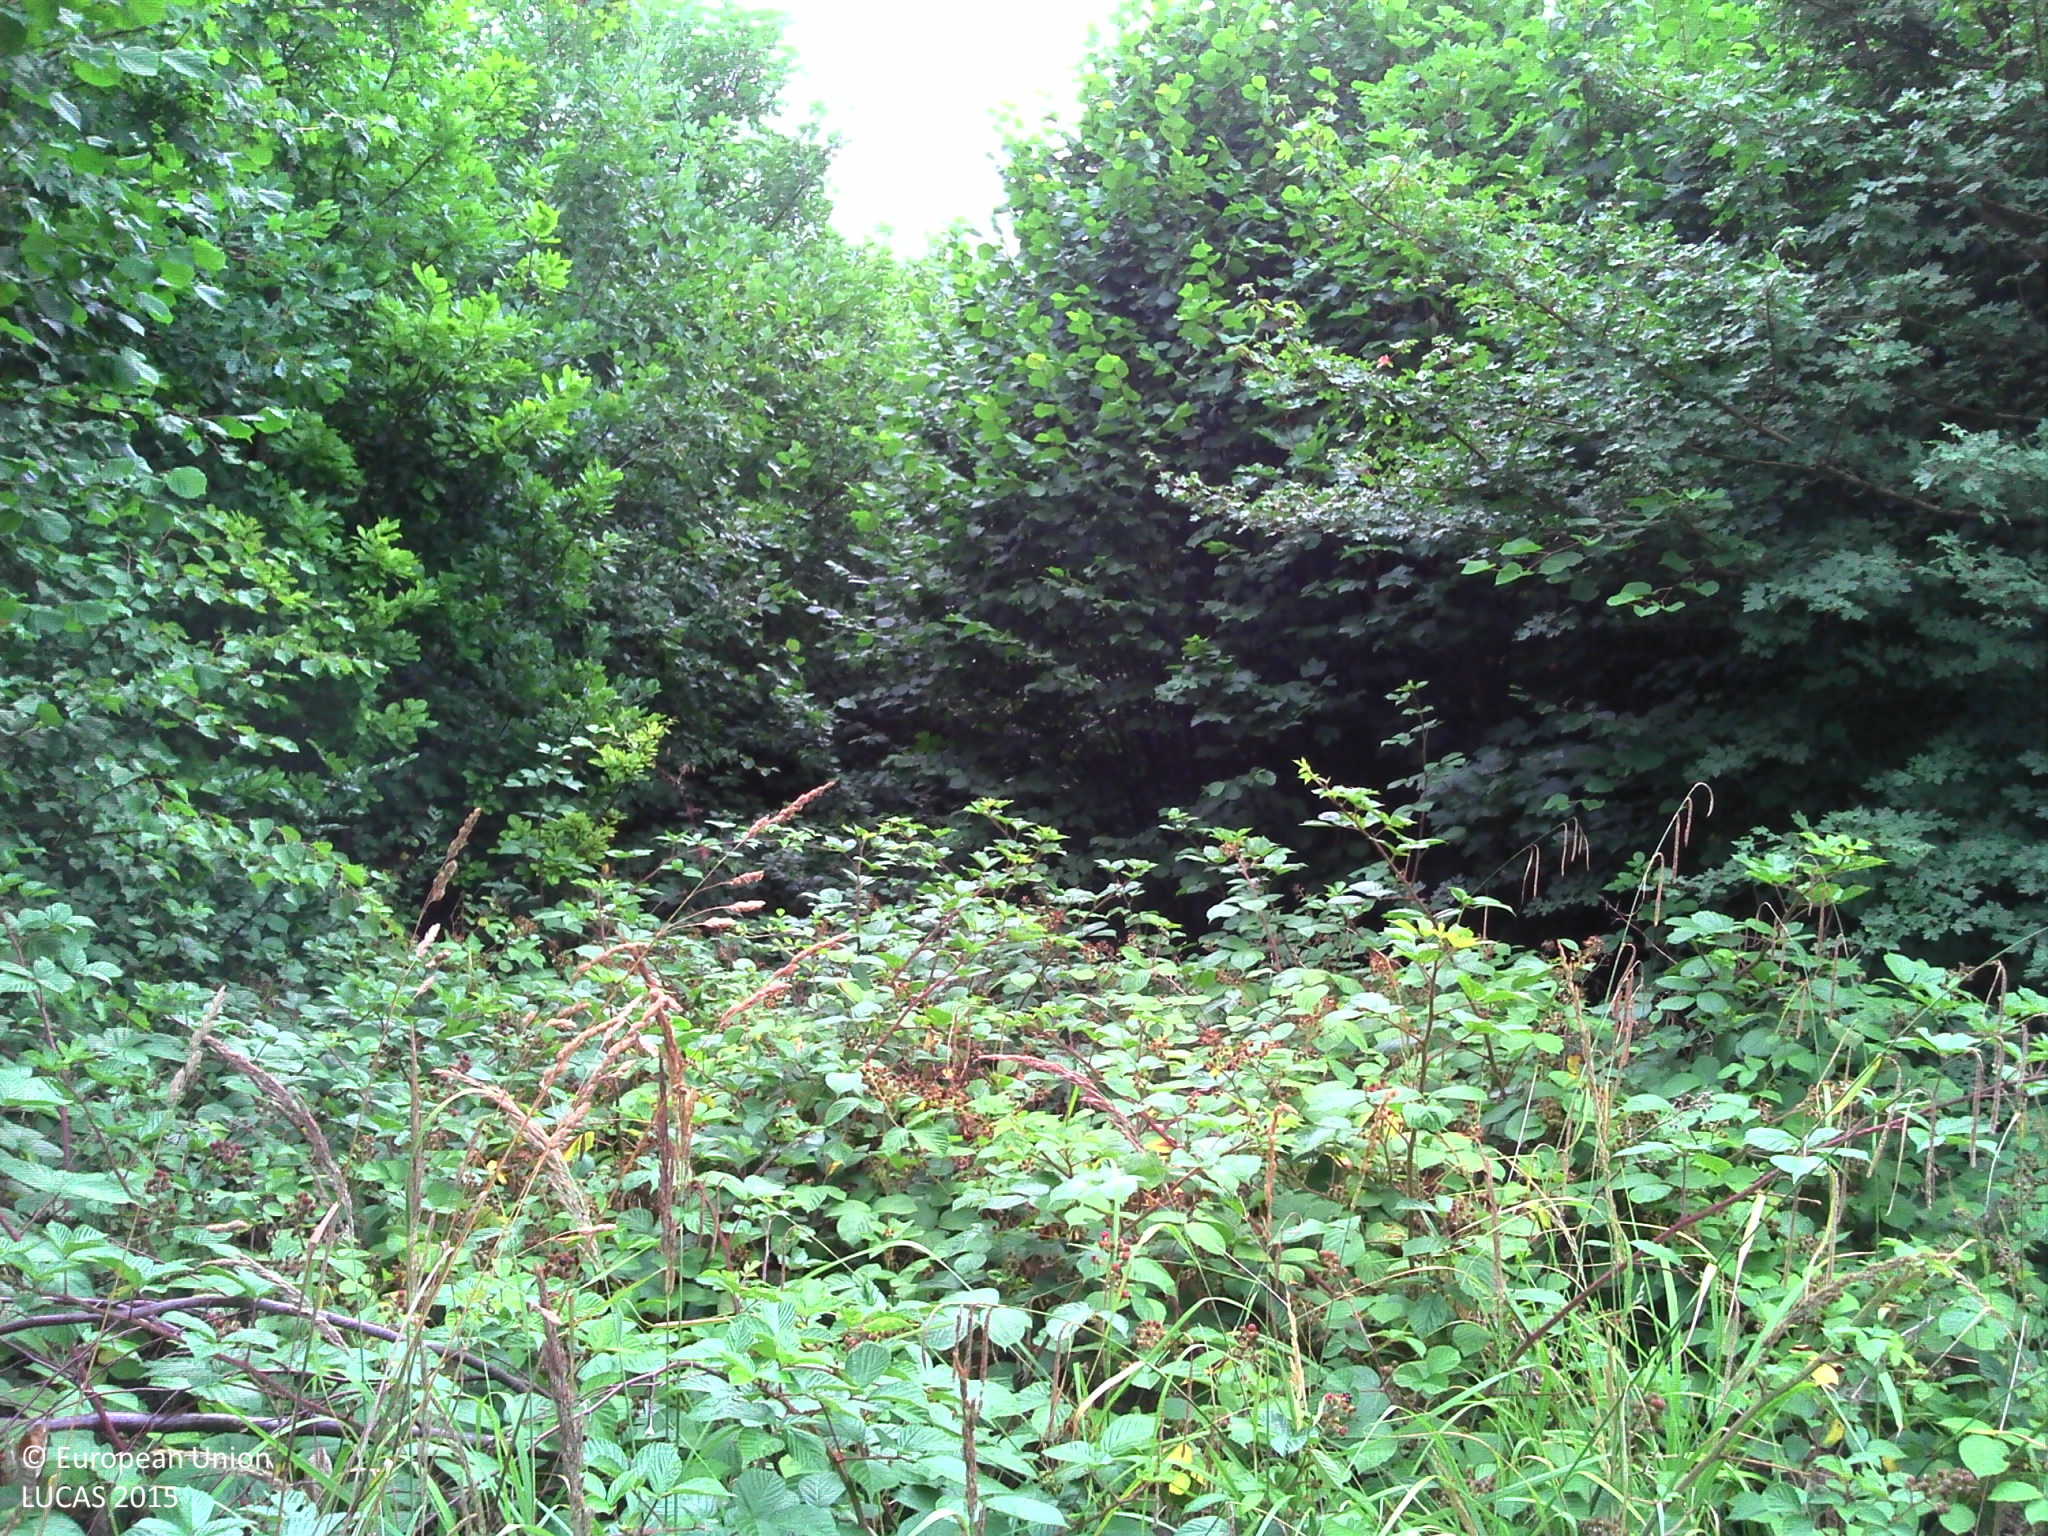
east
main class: Woodland
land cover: Broadleaved woodland
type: acidophilous oak and oak-birch forest
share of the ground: > 75 %
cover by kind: broadleaved forest trees 80 %, shrubs 15 %, herbaceous plants 5 %
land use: Forestry
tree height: > 5 m
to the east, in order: Broadleaved woodland
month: July
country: FR
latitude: 49.2365
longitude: 2.5584
